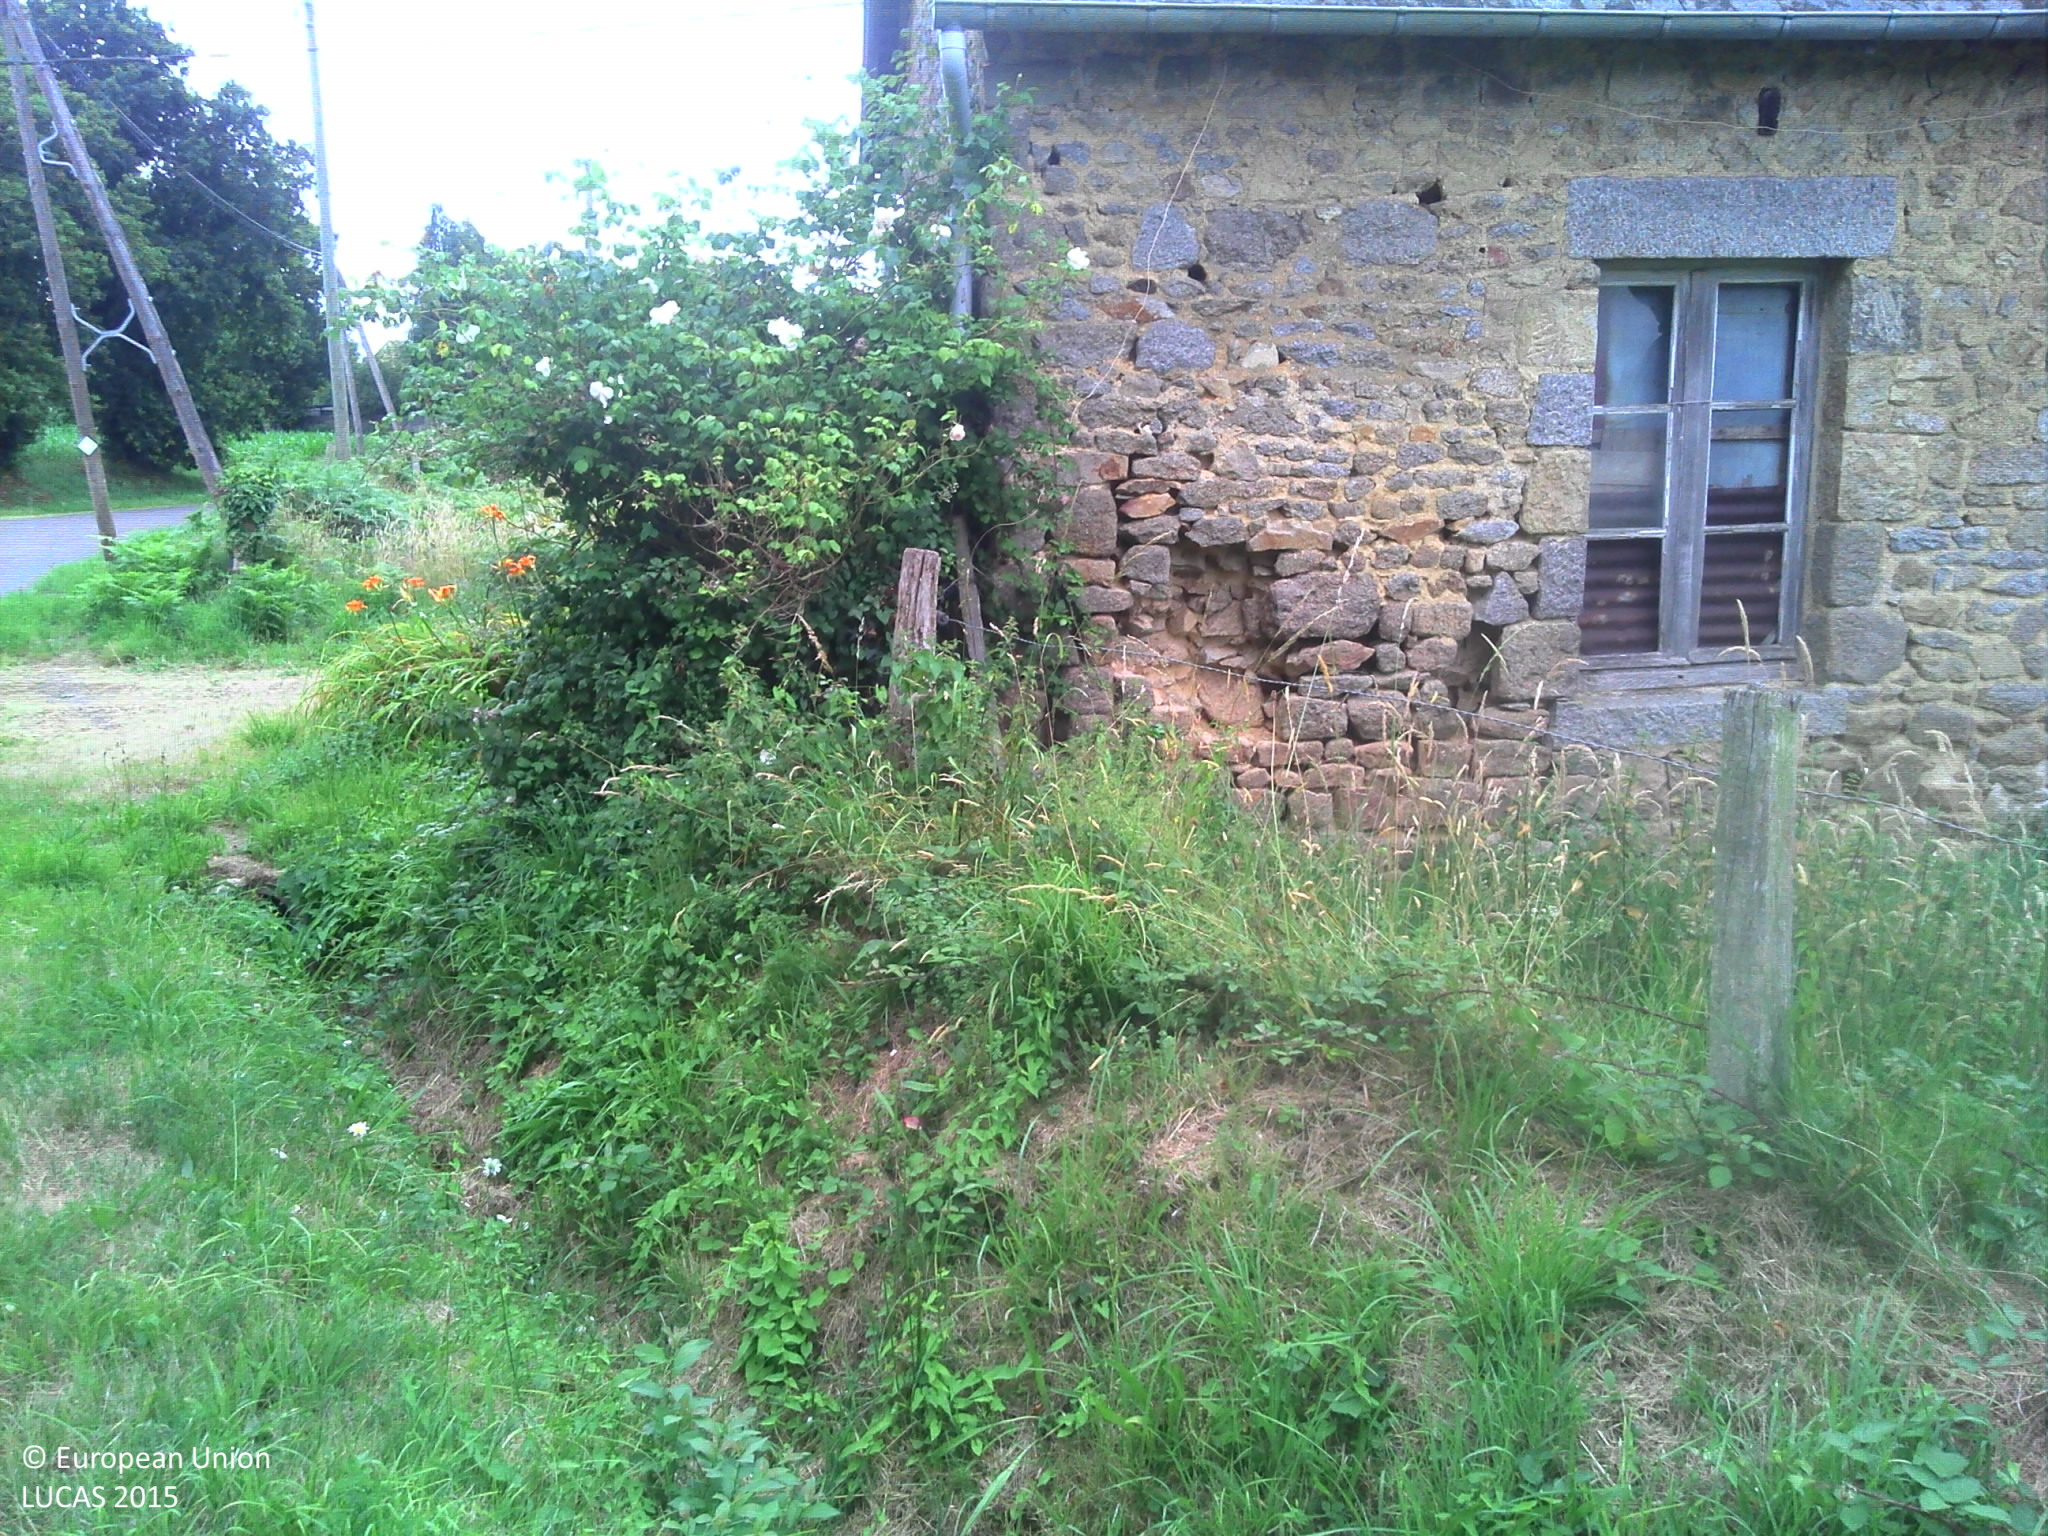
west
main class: Grassland
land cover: Grassland without tree/shrub cover
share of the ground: > 75 %
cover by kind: herbaceous plants 100 %
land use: Agriculture (excluding fallow land and kitchen gardens)
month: July
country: FR
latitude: 48.7599
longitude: -1.5433
